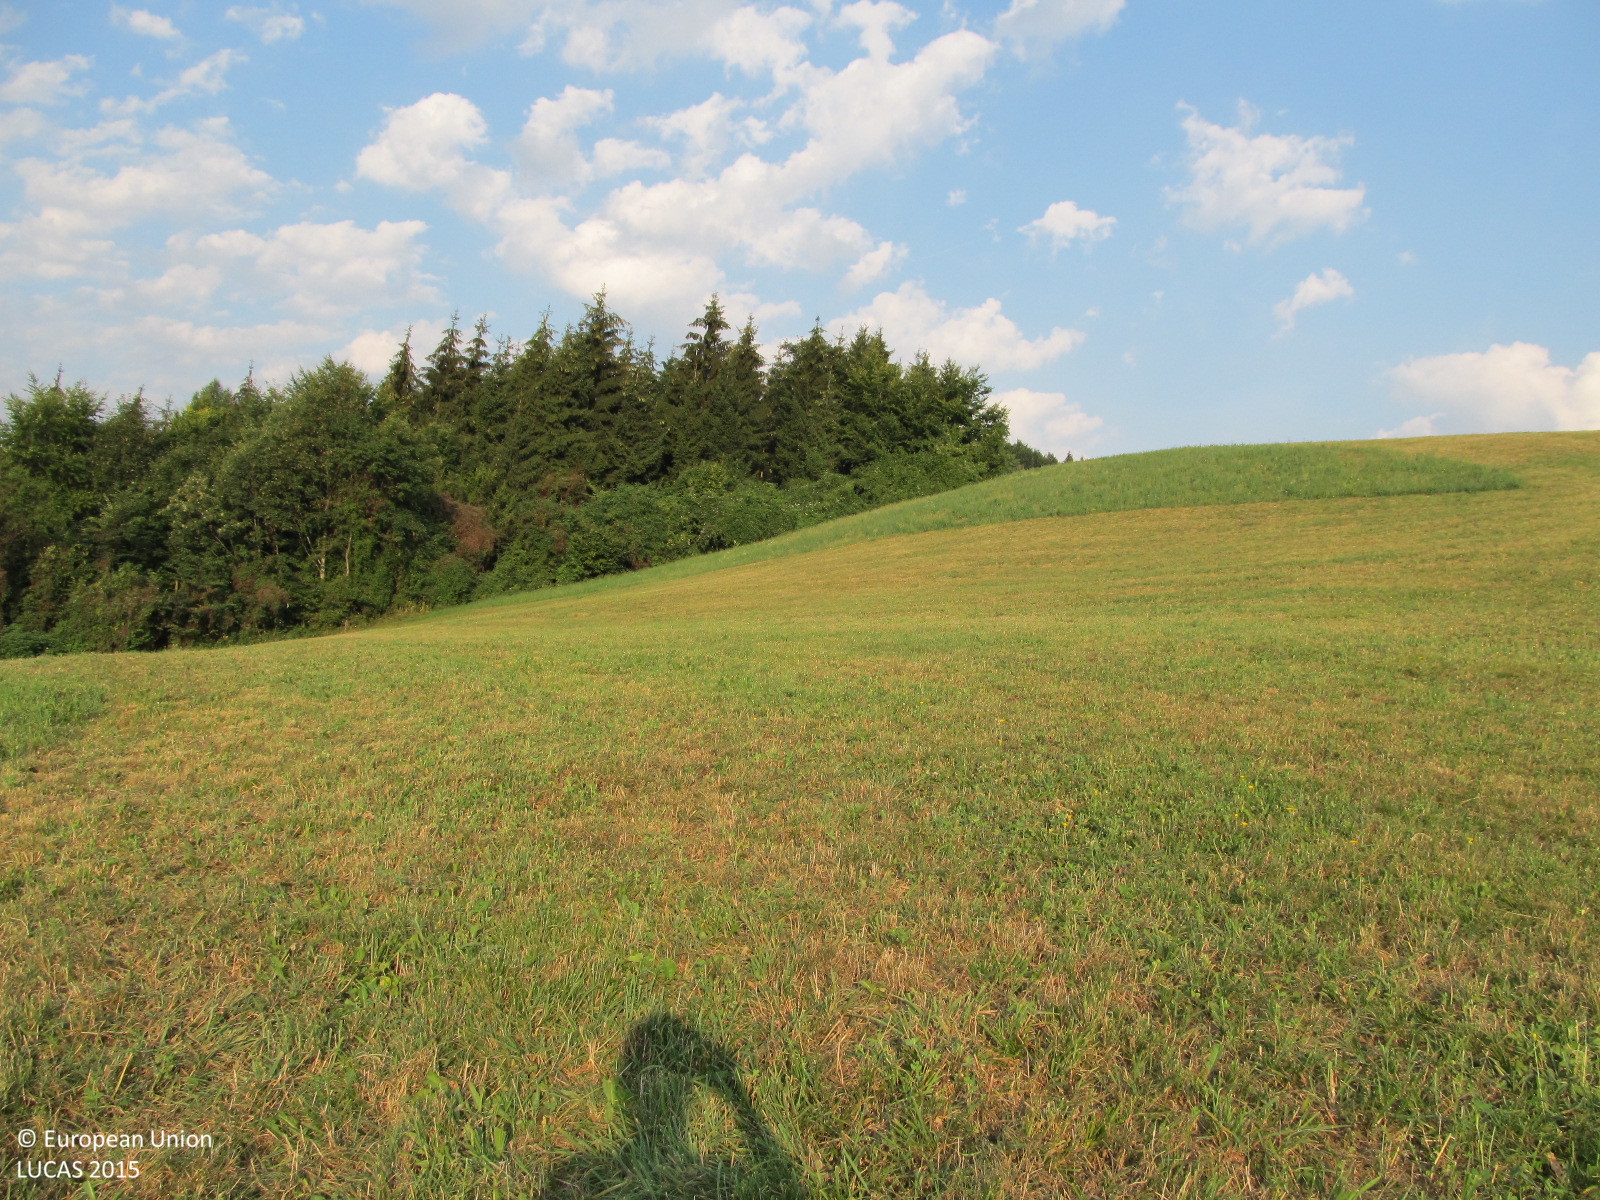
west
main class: Grassland
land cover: Grassland without tree/shrub cover
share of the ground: > 75 %
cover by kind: herbaceous plants 100 %
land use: Agriculture (excluding fallow land and kitchen gardens)
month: August
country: AT
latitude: 48.0381
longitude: 15.3801
